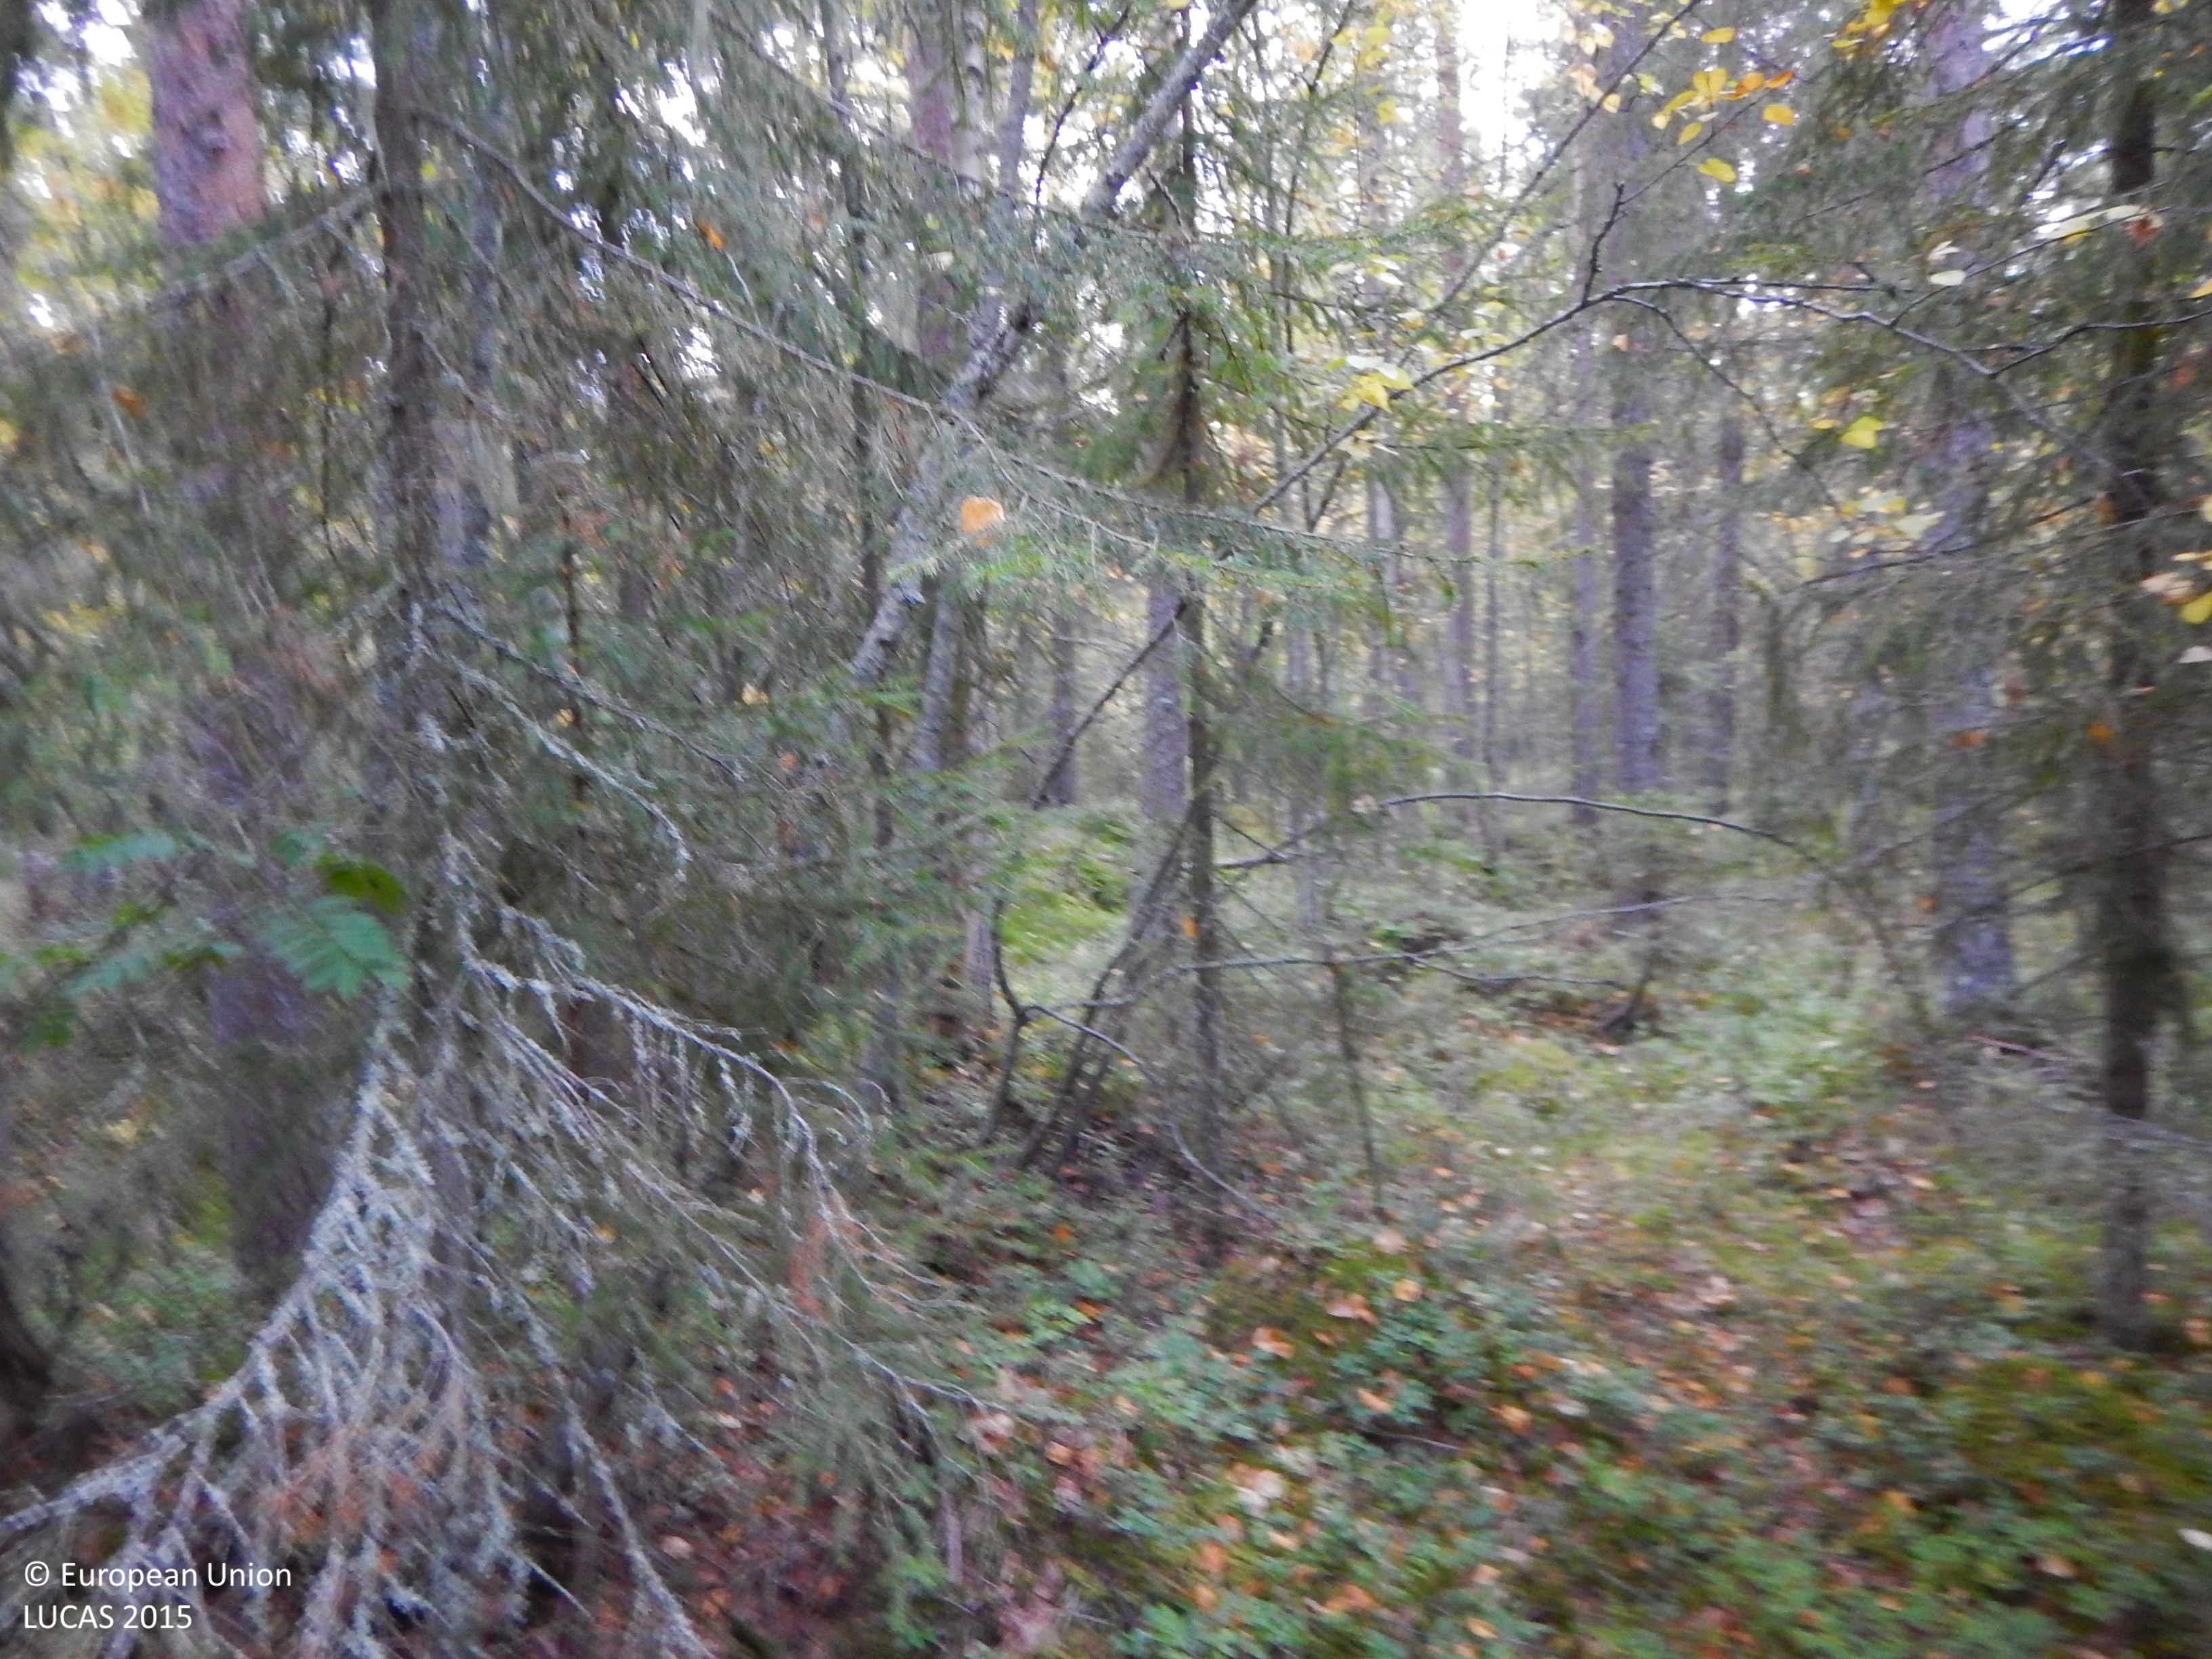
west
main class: Woodland
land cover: Other coniferous woodland
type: boreal forest
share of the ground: 50 - 75 %
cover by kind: coniferous forest trees 45 %, shrubs 25 %, broadleaved forest trees 15 %, lichens and mosses 15 %
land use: Forestry
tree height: > 5 m
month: September
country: SE
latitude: 64.7490
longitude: 20.1201
